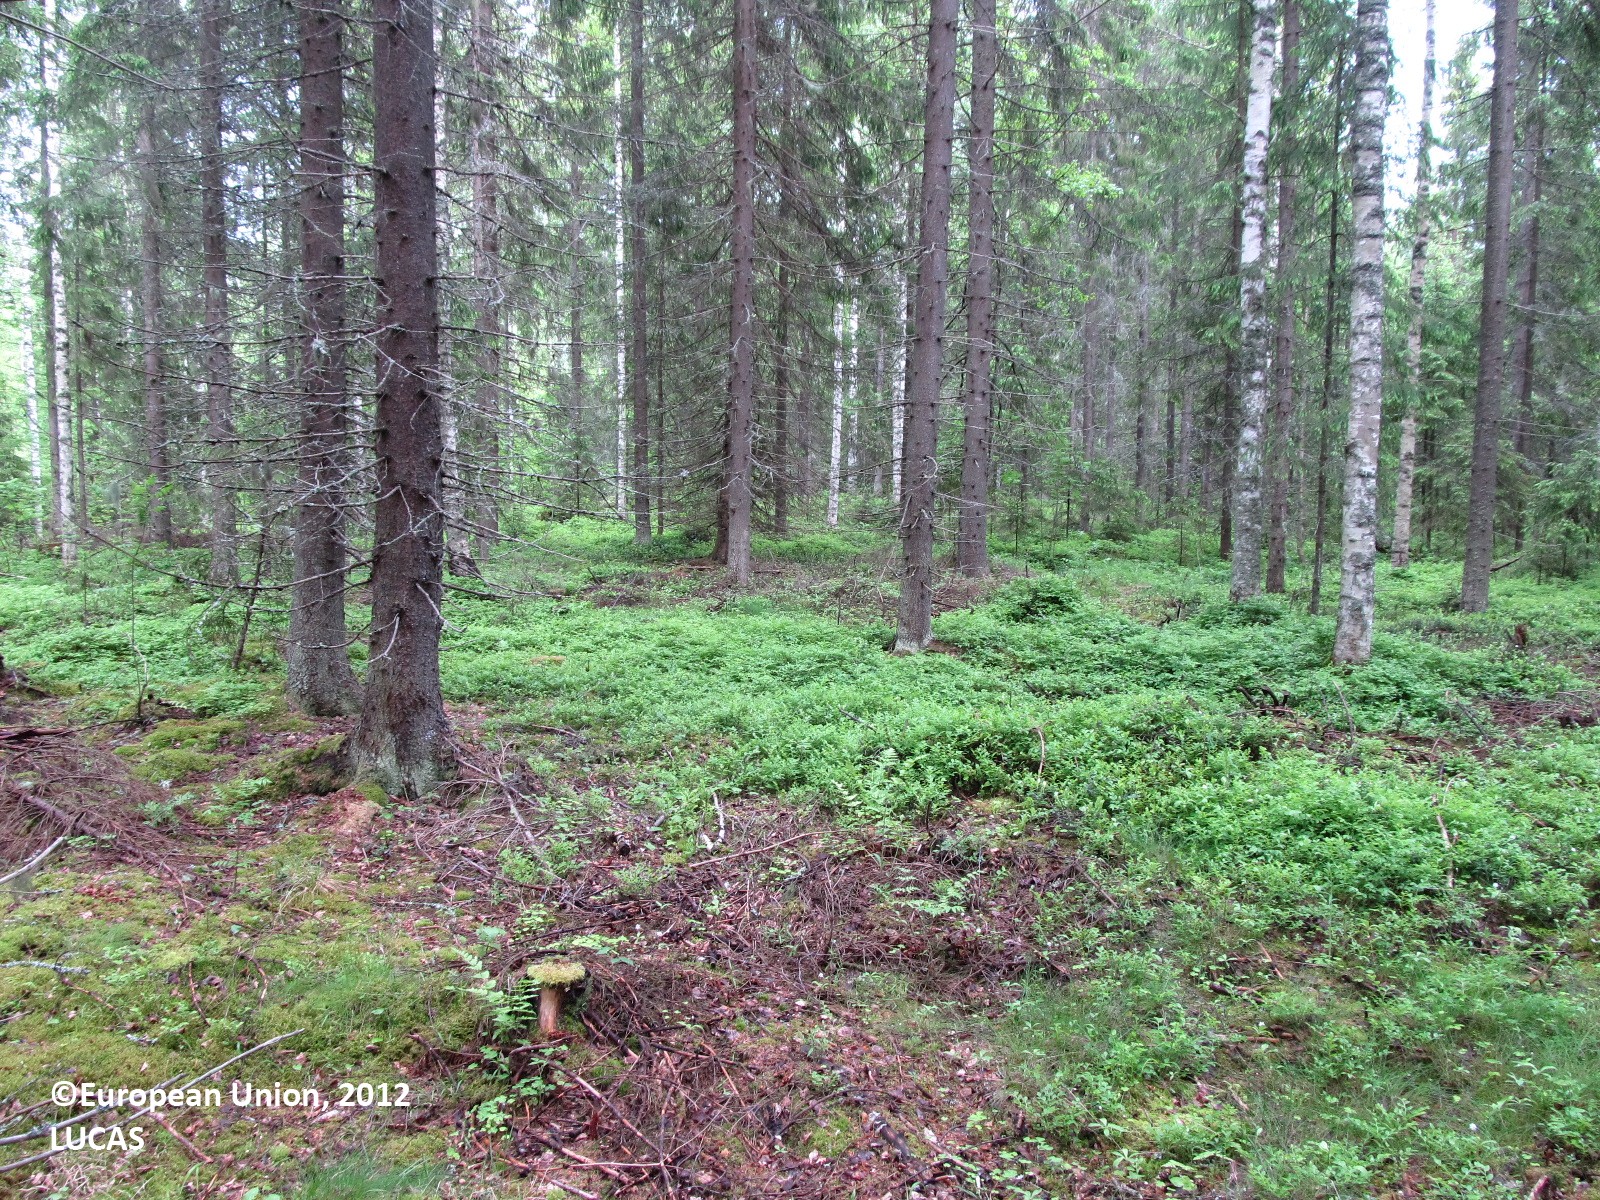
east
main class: Woodland
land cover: Spruce dominated coniferous woodland
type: boreal forest
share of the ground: 25 - 50 %
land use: Forestry
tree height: > 5 m
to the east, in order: Spruce dominated coniferous woodland; Other bare soil; Spruce dominated coniferous woodland; Ditches and canals; Grass margins; Paved roads, cycling and walking lanes; Grass margins; Ditches and canals; Broadleaved woodland; Grassland without tree/shrub cover; Spruce dominated mixed woodland; Grassland with sparse tree/shrub cover; Spruce dominated coniferous woodland; Ditches and canals; Spruce dominated coniferous woodland; Other bare soil; Spruce dominated coniferous woodland; Other bare soil; Spruce dominated mixed woodland; Artificial constructions in urban areas
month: June
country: FI
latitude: 62.9249
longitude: 28.1643
